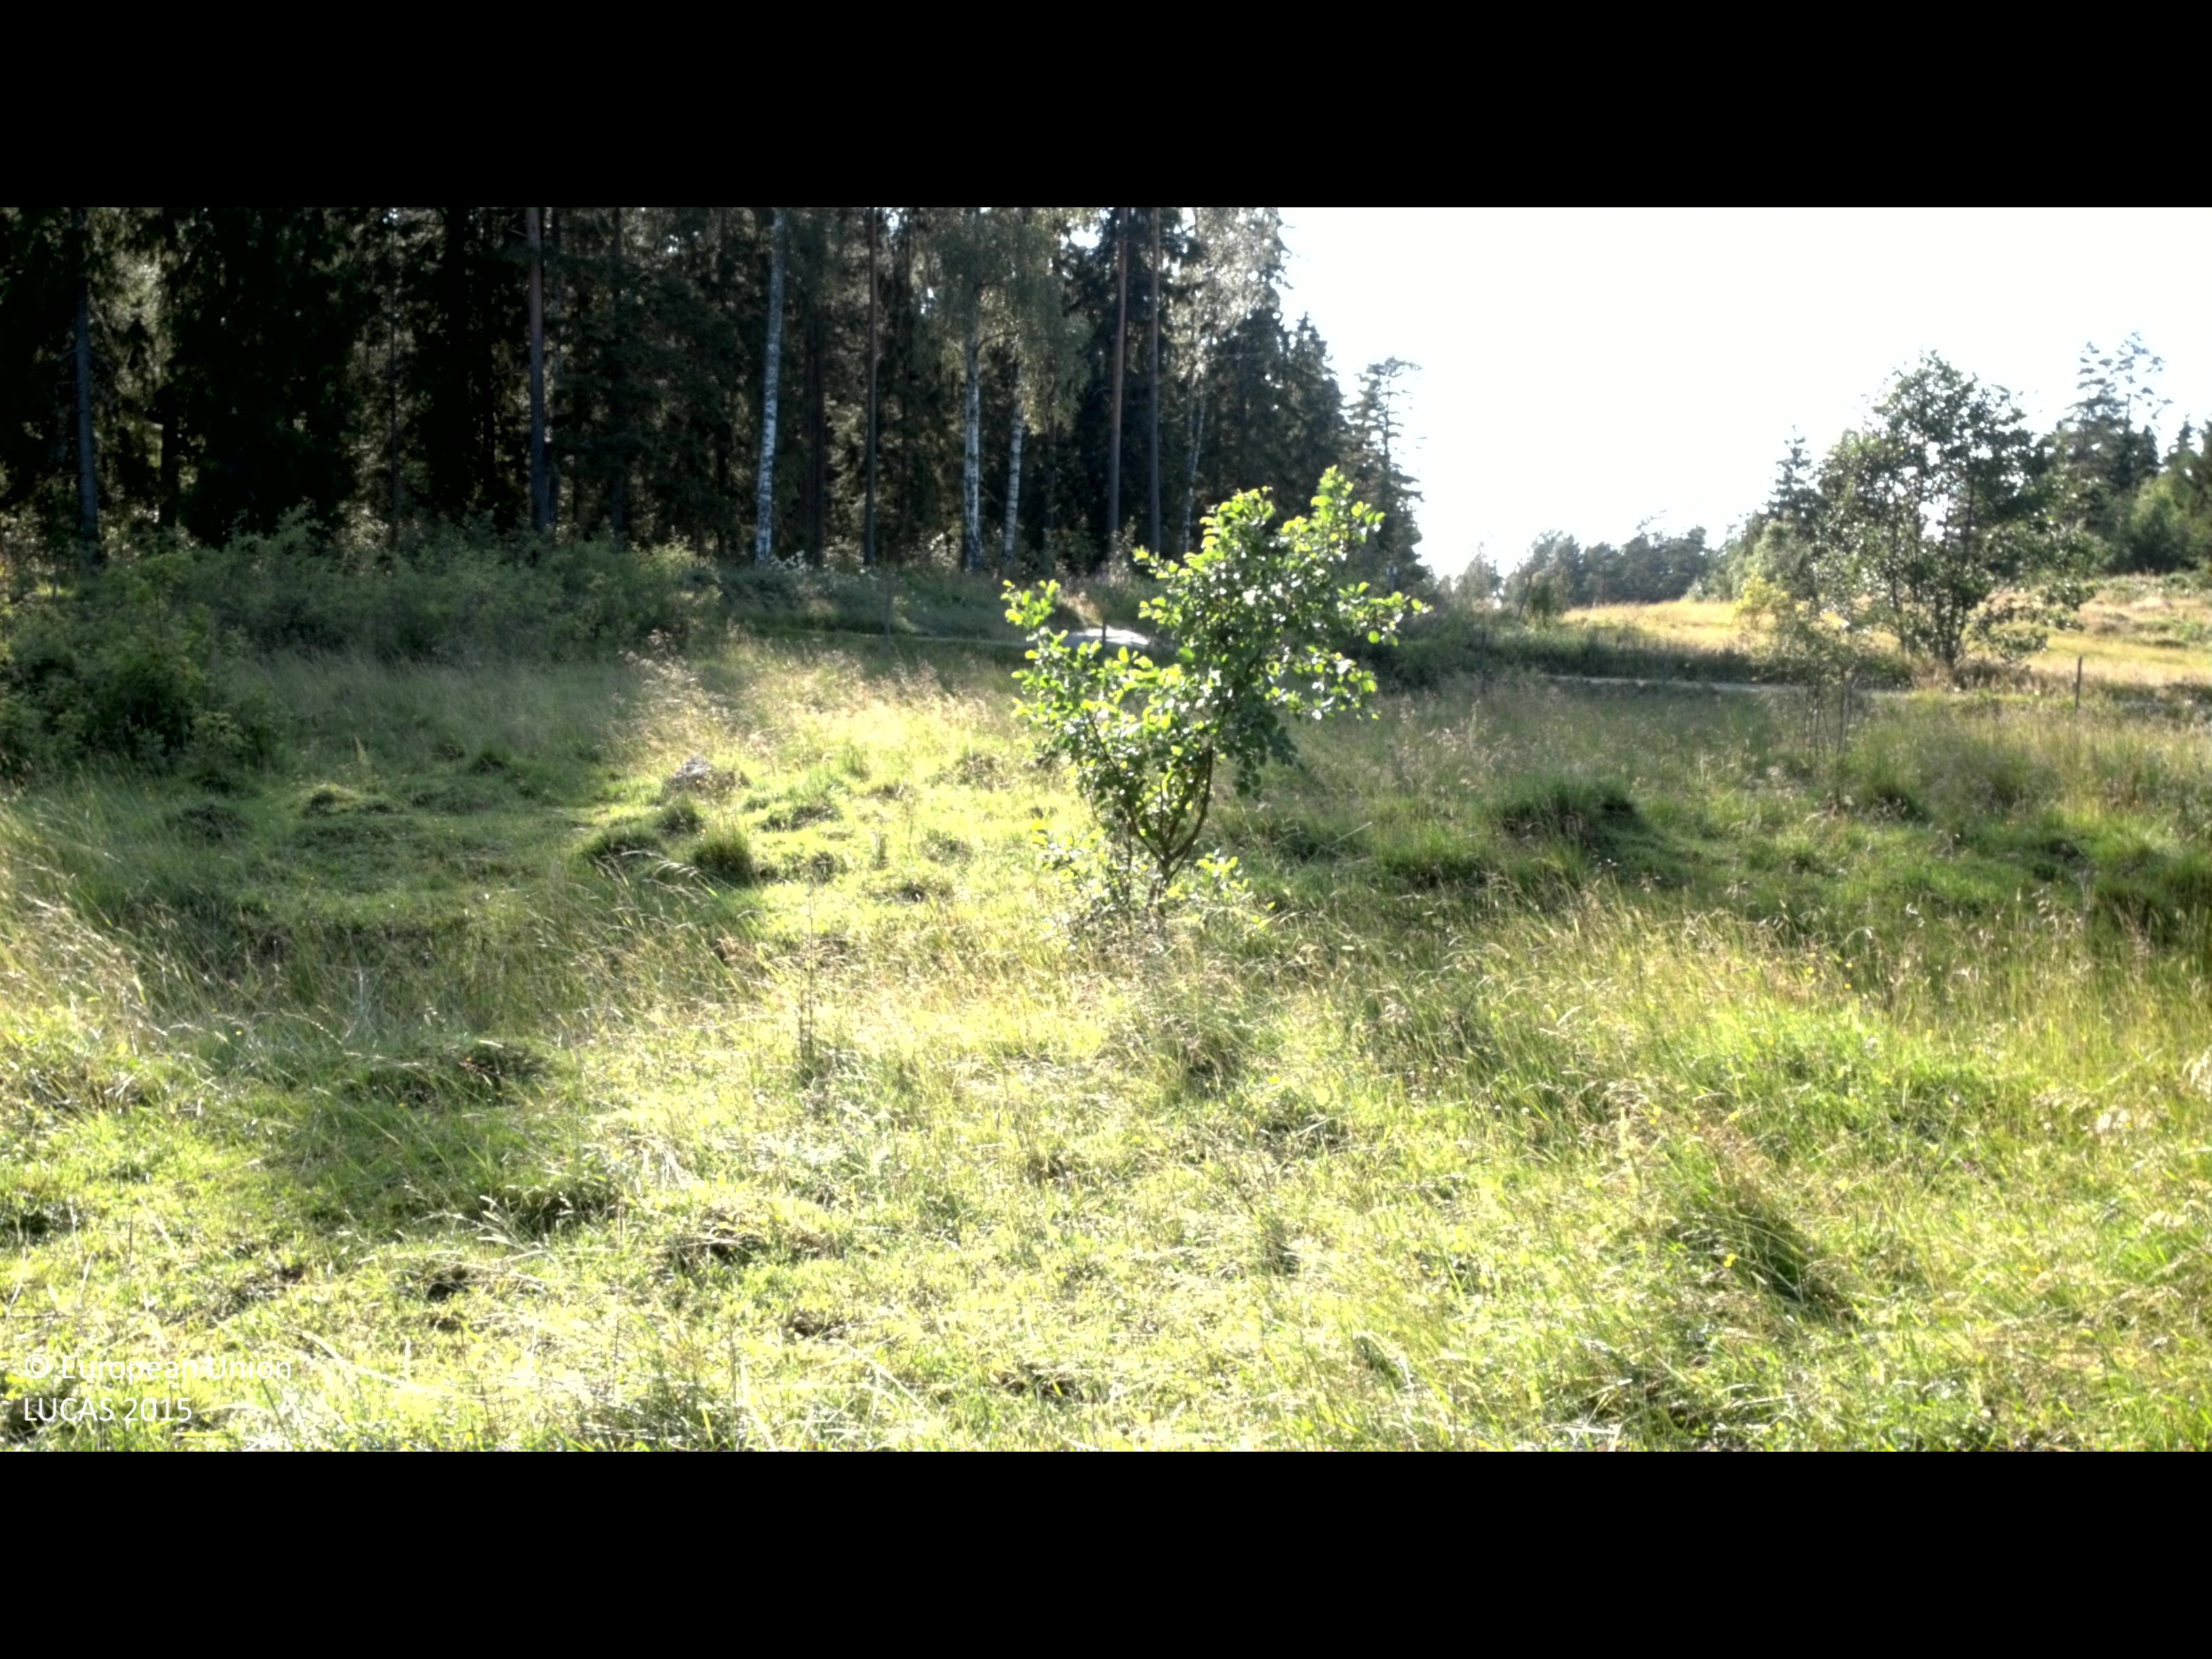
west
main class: Grassland
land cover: Grassland with sparse tree/shrub cover
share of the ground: > 75 %
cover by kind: herbaceous plants 85 %, shrubs 10 %, broadleaved forest trees 5 %
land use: Agriculture (excluding fallow land and kitchen gardens)
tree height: > 5 m
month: July
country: SE
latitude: 58.3378
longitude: 16.4016
